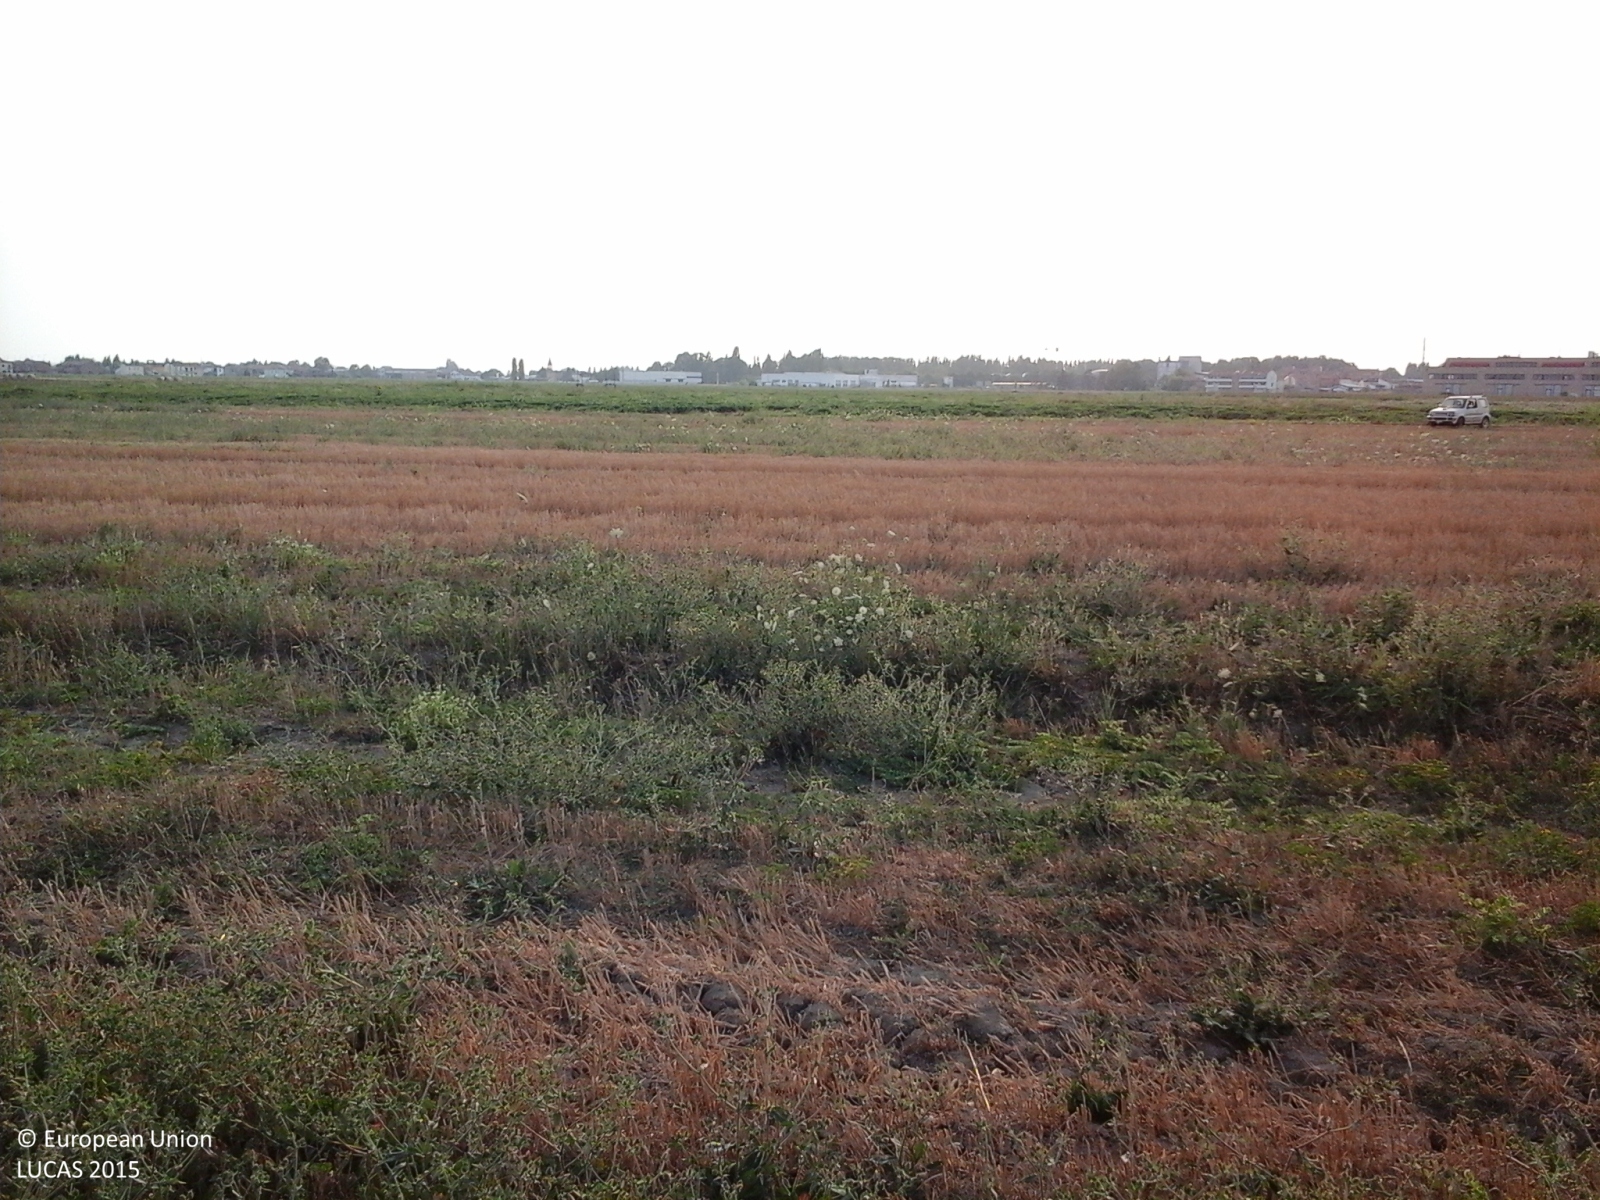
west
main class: Cropland
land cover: Common wheat
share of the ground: > 75 %
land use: Agriculture (excluding fallow land and kitchen gardens)
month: July
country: IT
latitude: 44.8071
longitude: 11.6025
